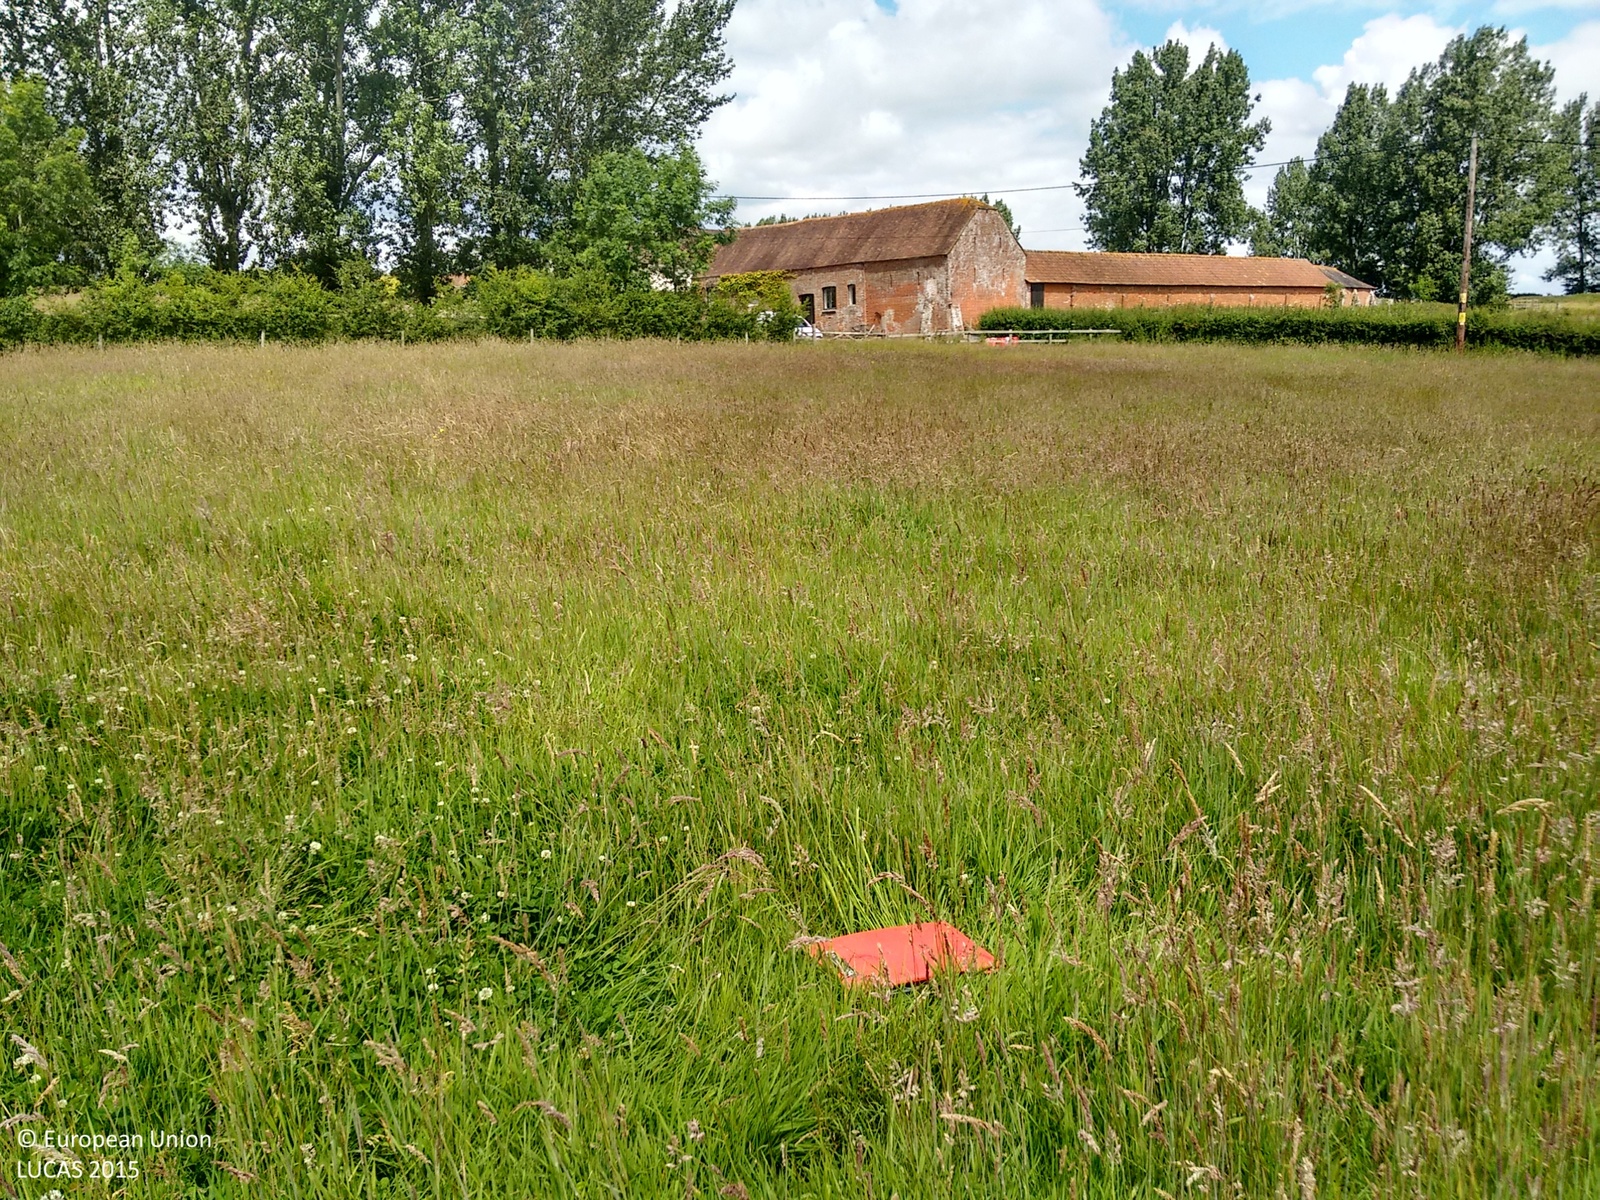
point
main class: Grassland
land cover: Grassland without tree/shrub cover
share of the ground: > 75 %
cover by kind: herbaceous plants 100 %
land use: Agriculture (excluding fallow land and kitchen gardens)
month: June
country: GB
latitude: 50.7797
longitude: -2.0430
